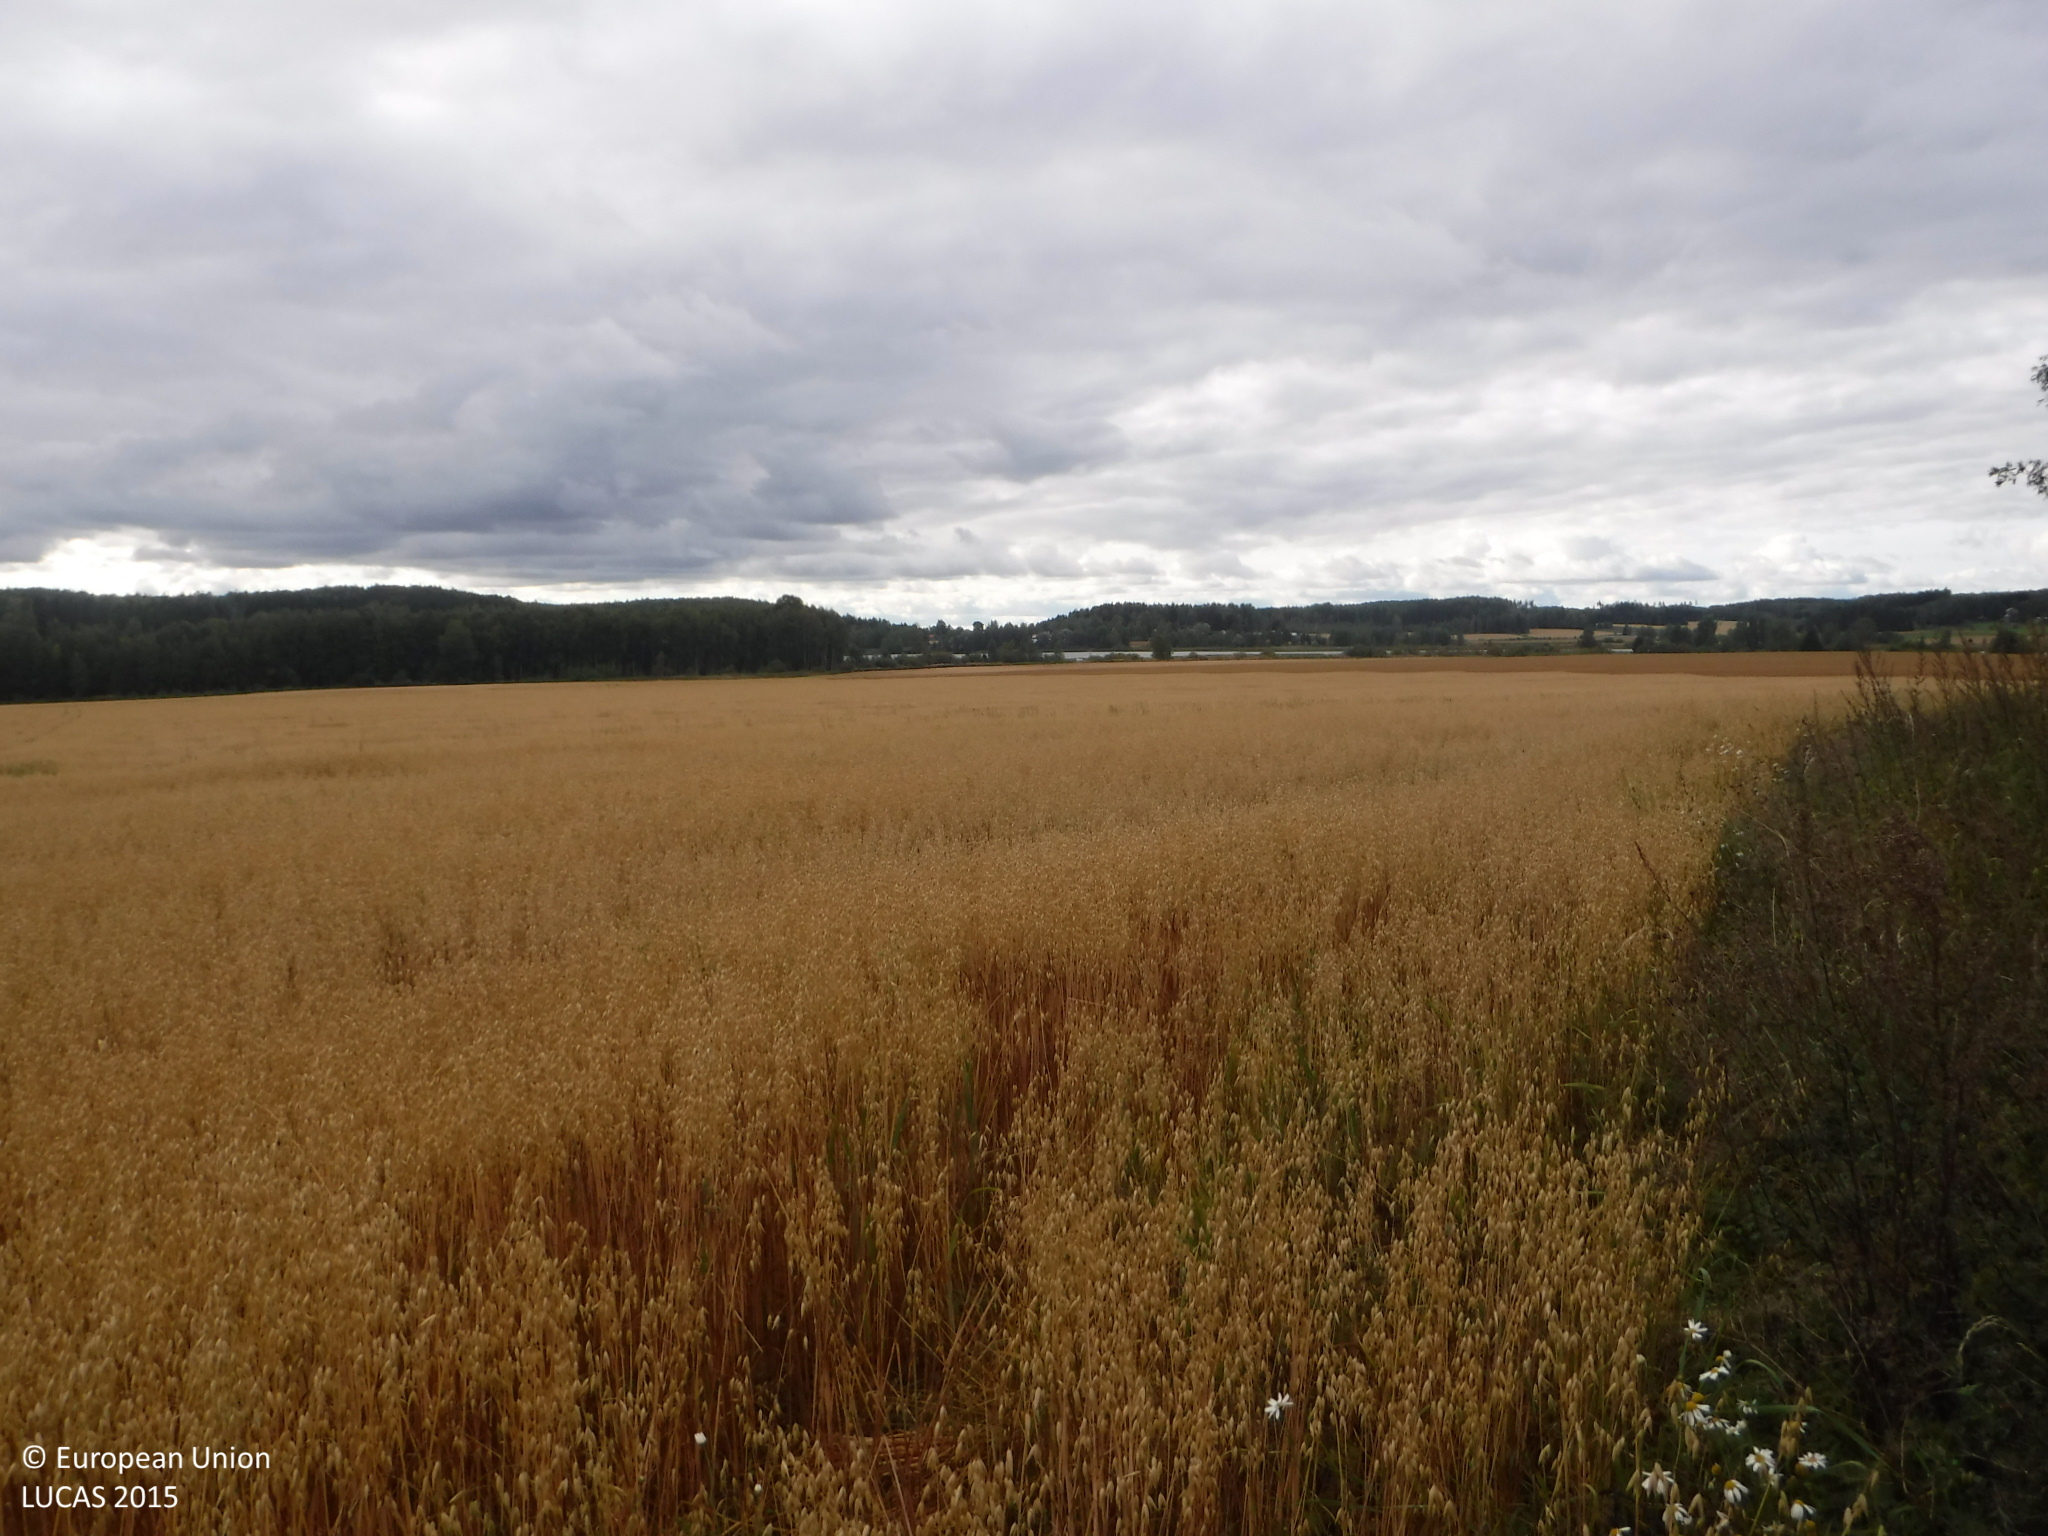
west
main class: Cropland
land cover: Oats
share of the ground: > 75 %
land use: Agriculture (excluding fallow land and kitchen gardens)
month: September
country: FI
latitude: 61.3794
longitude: 23.0797
